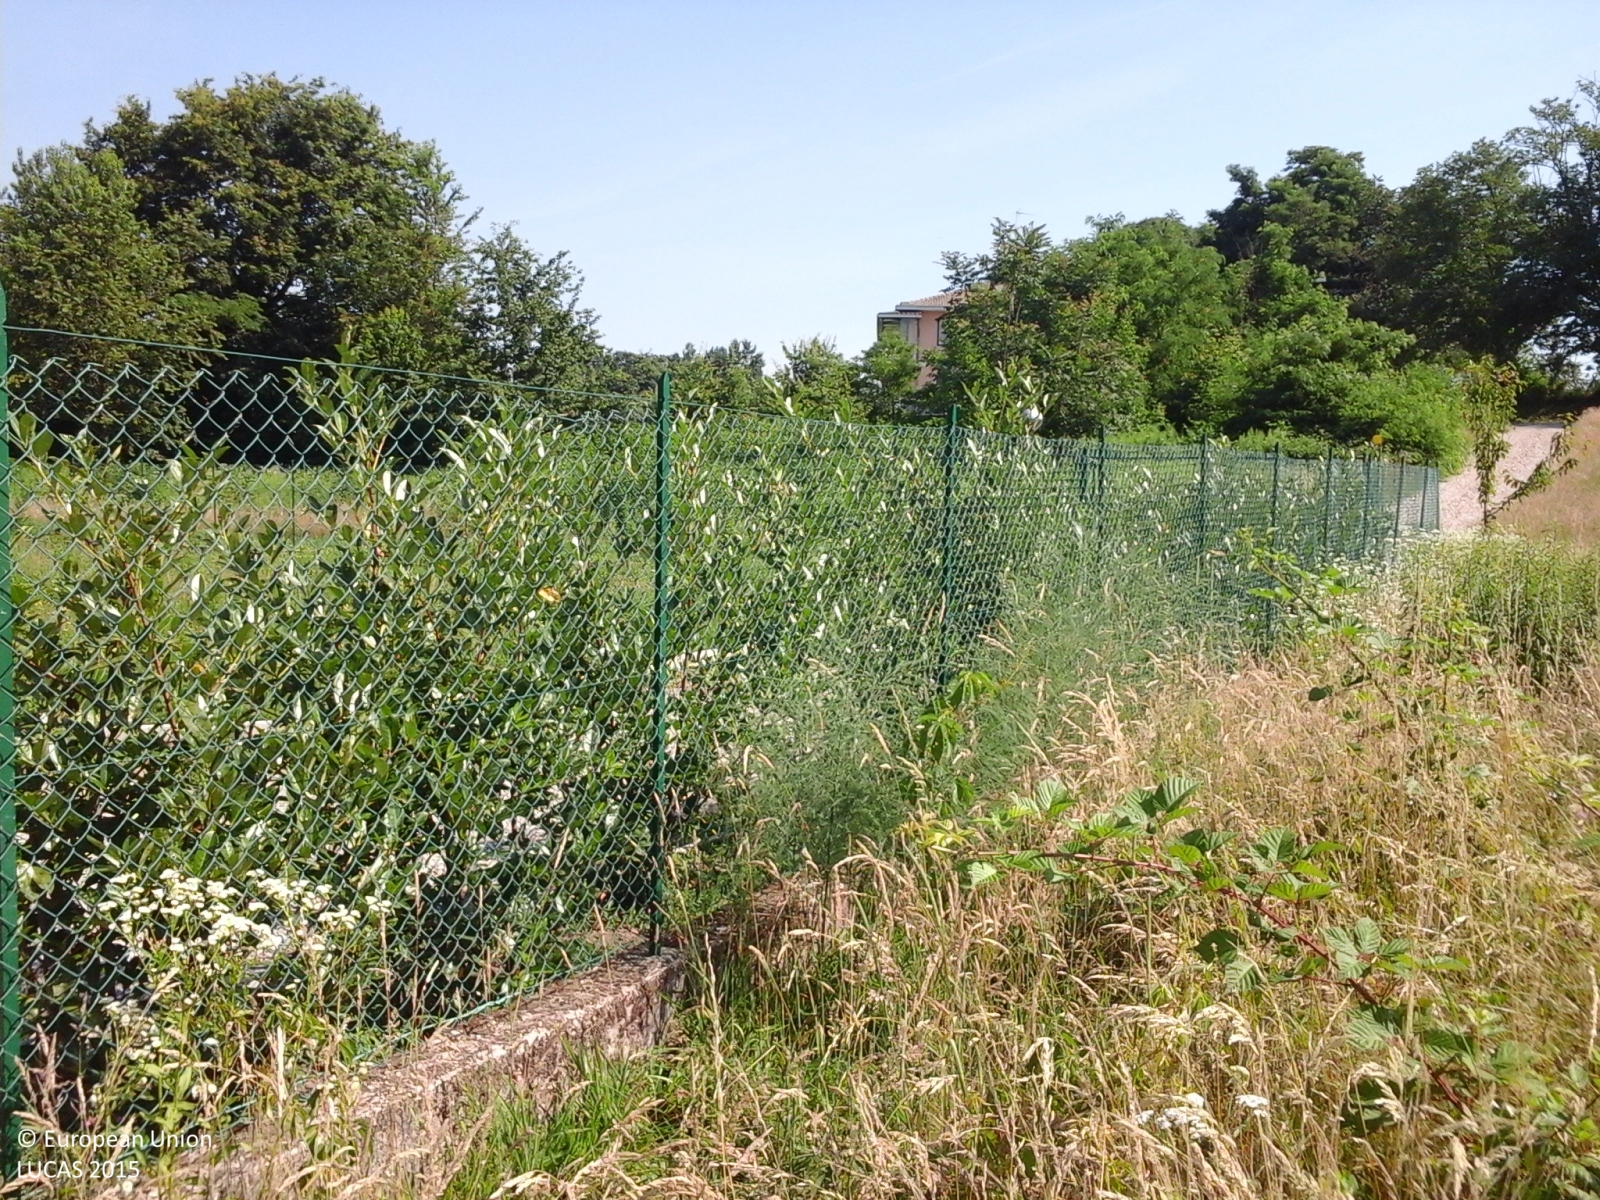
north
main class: Grassland
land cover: Grassland with sparse tree/shrub cover
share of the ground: > 75 %
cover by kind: herbaceous plants 95 %, broadleaved forest trees 5 %
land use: Residential
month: June
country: IT
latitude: 45.6776
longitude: 8.7823
